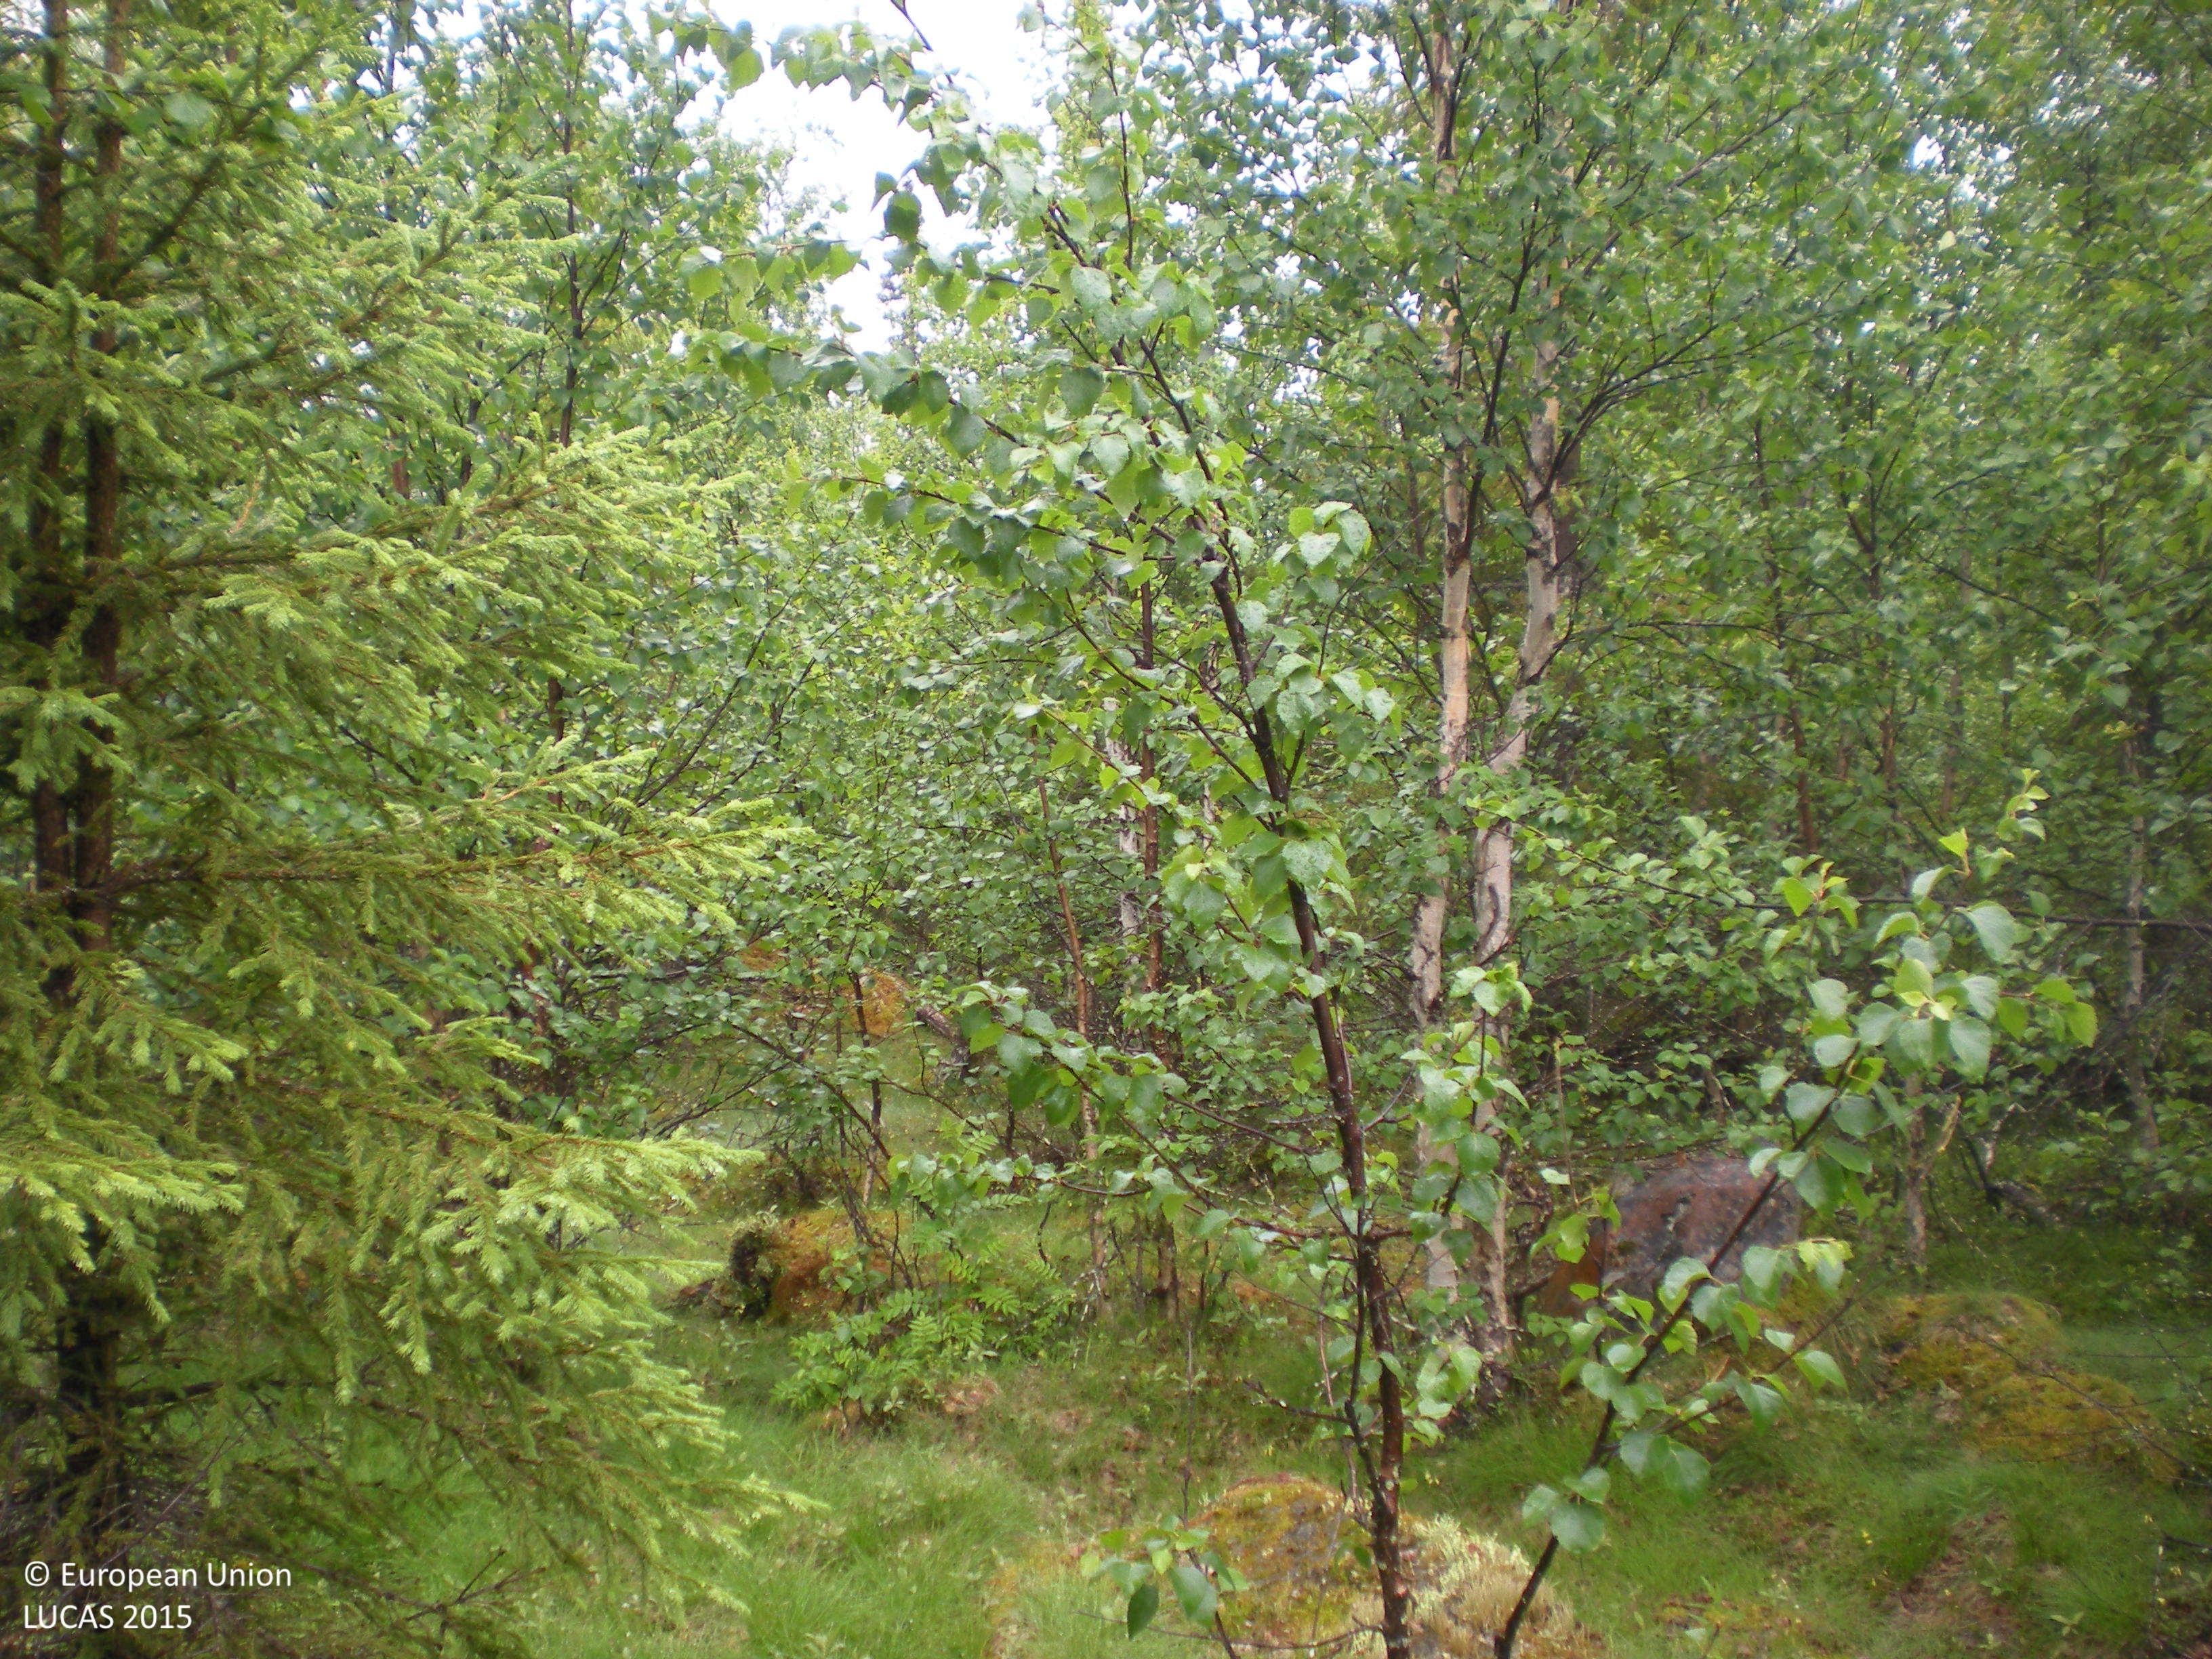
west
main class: Woodland
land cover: Spruce dominated mixed woodland
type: boreal forest
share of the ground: 50 - 75 %
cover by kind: broadleaved forest trees 55 %, coniferous forest trees 20 %, herbaceous plants 15 %, lichens and mosses 10 %
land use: Forestry
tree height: > 5 m
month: July
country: SE
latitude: 65.8700
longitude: 17.1697
